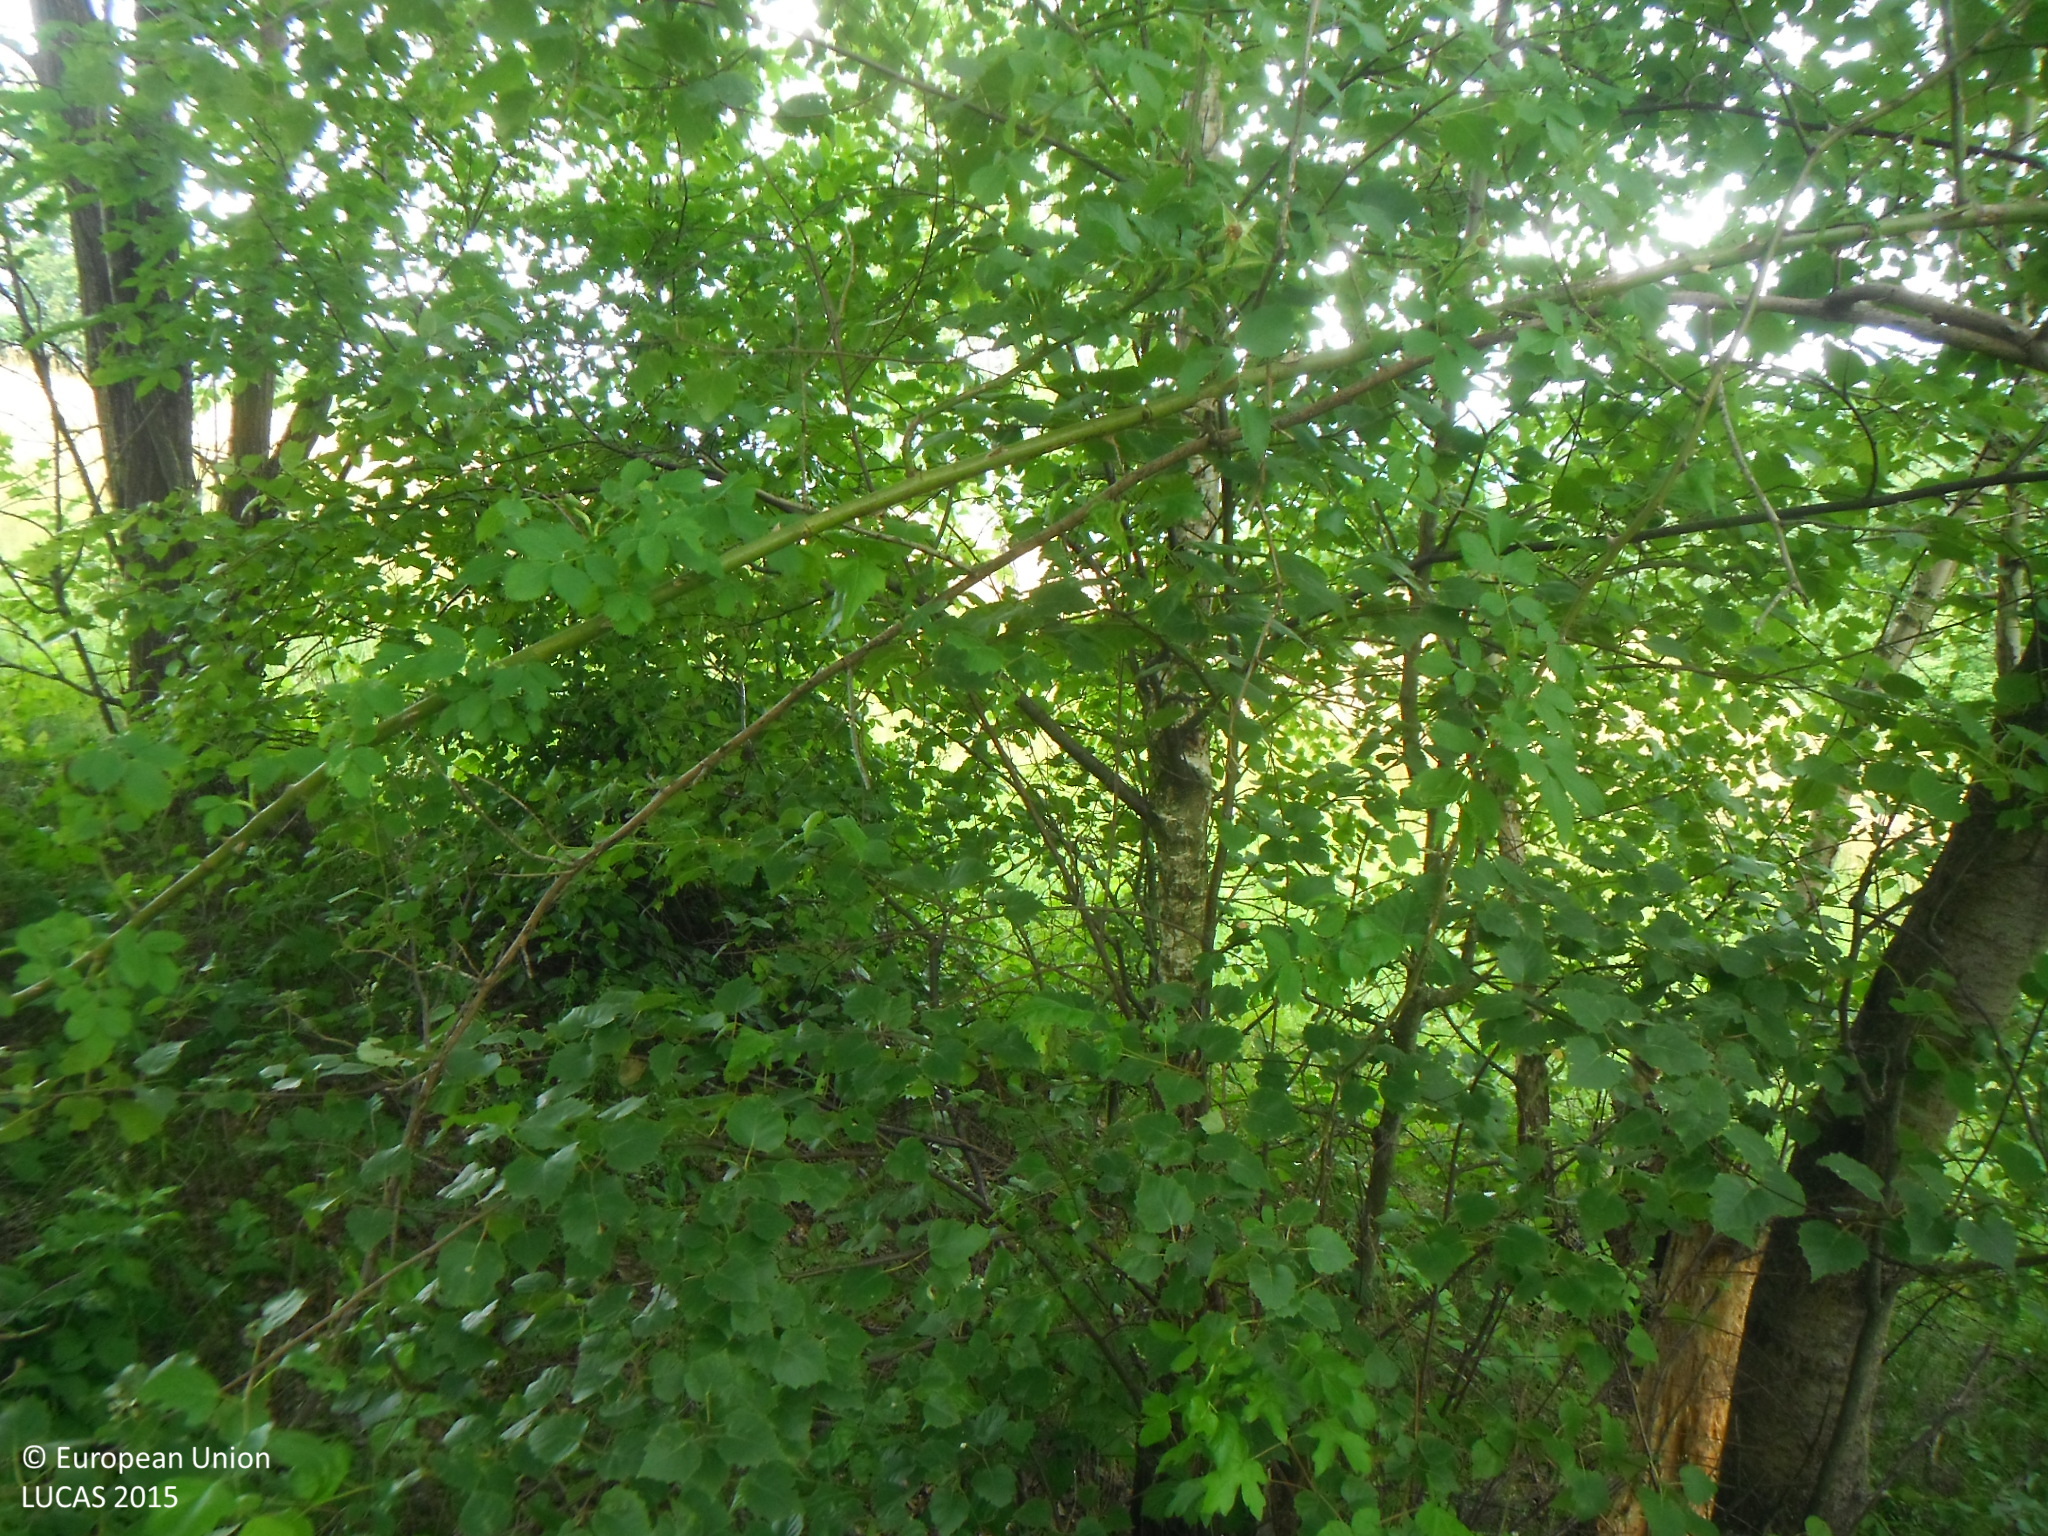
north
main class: Woodland
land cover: Broadleaved woodland
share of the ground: > 75 %
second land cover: Grassland without tree/shrub cover
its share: > 75 %
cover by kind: broadleaved forest trees 70 %, herbaceous plants 30 %
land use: Forestry
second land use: Agriculture (excluding fallow land and kitchen gardens)
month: June
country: SK
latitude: 49.0830
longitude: 21.9253
